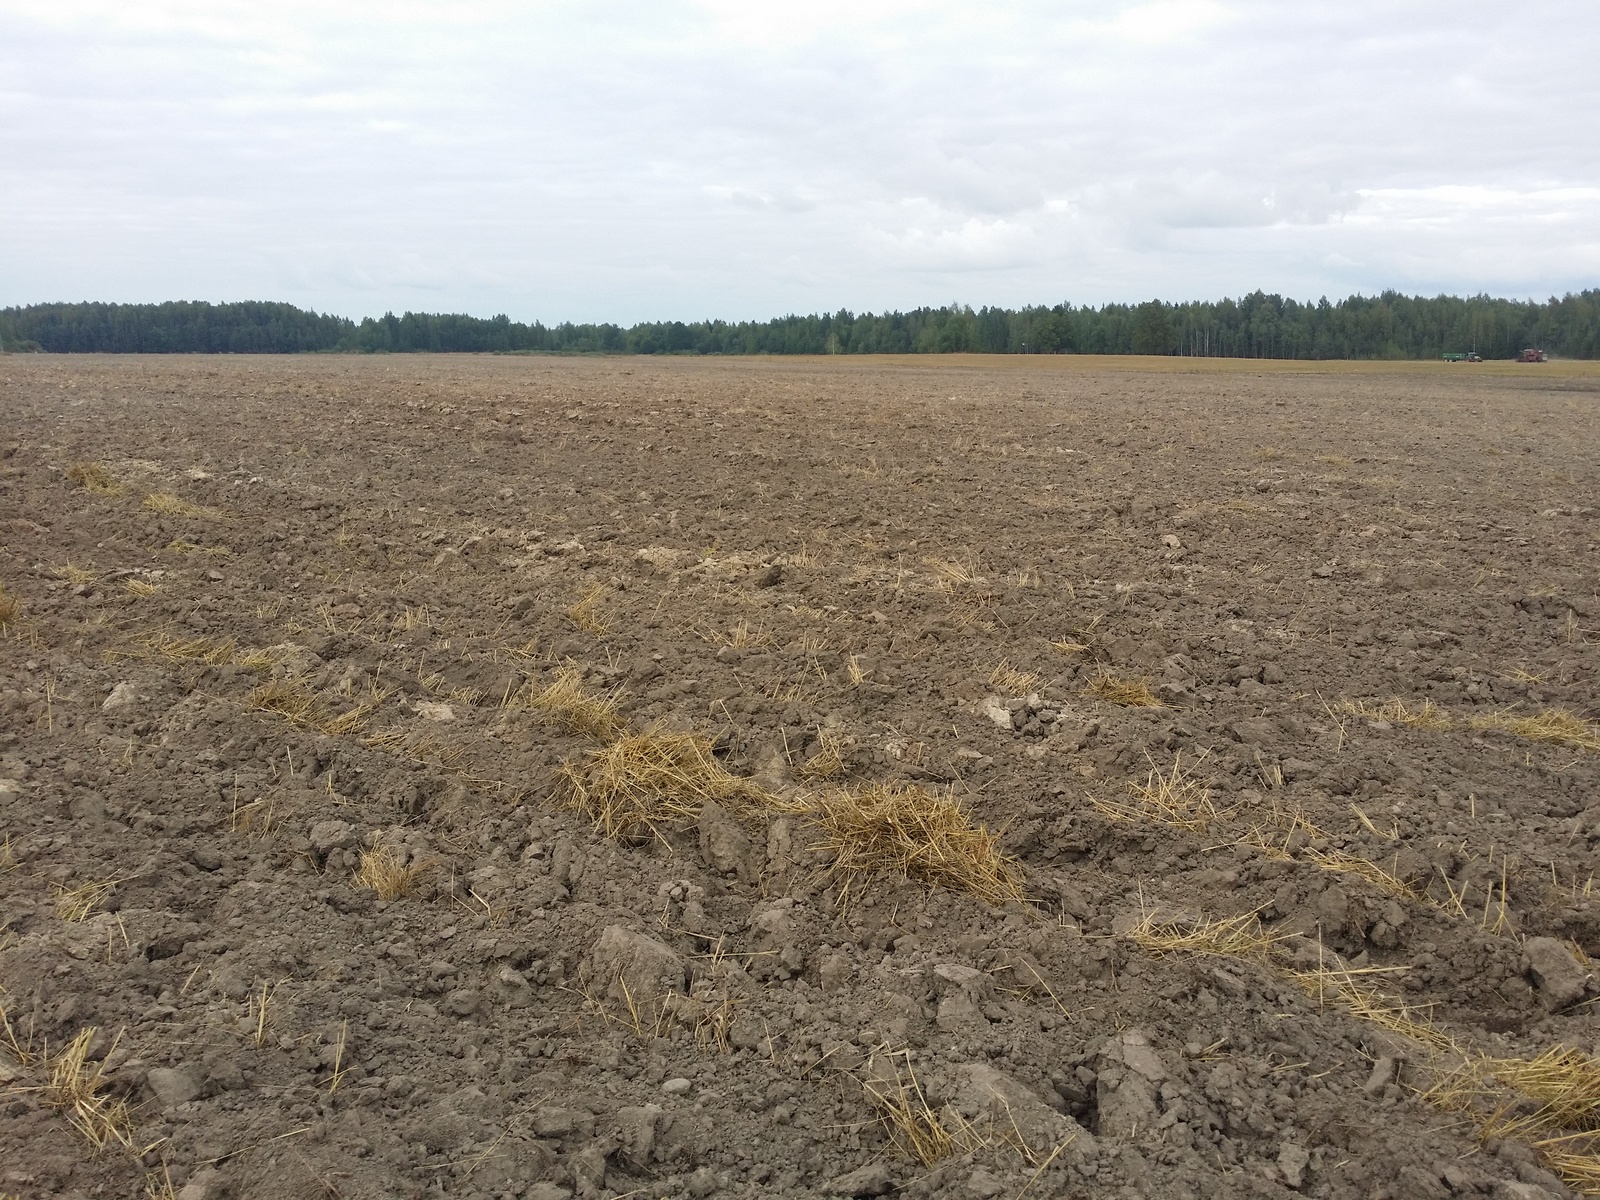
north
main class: Cropland
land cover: Common wheat
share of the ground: < 10 %
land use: Agriculture (excluding fallow land and kitchen gardens)
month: September
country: LV
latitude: 57.0167
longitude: 27.1117
